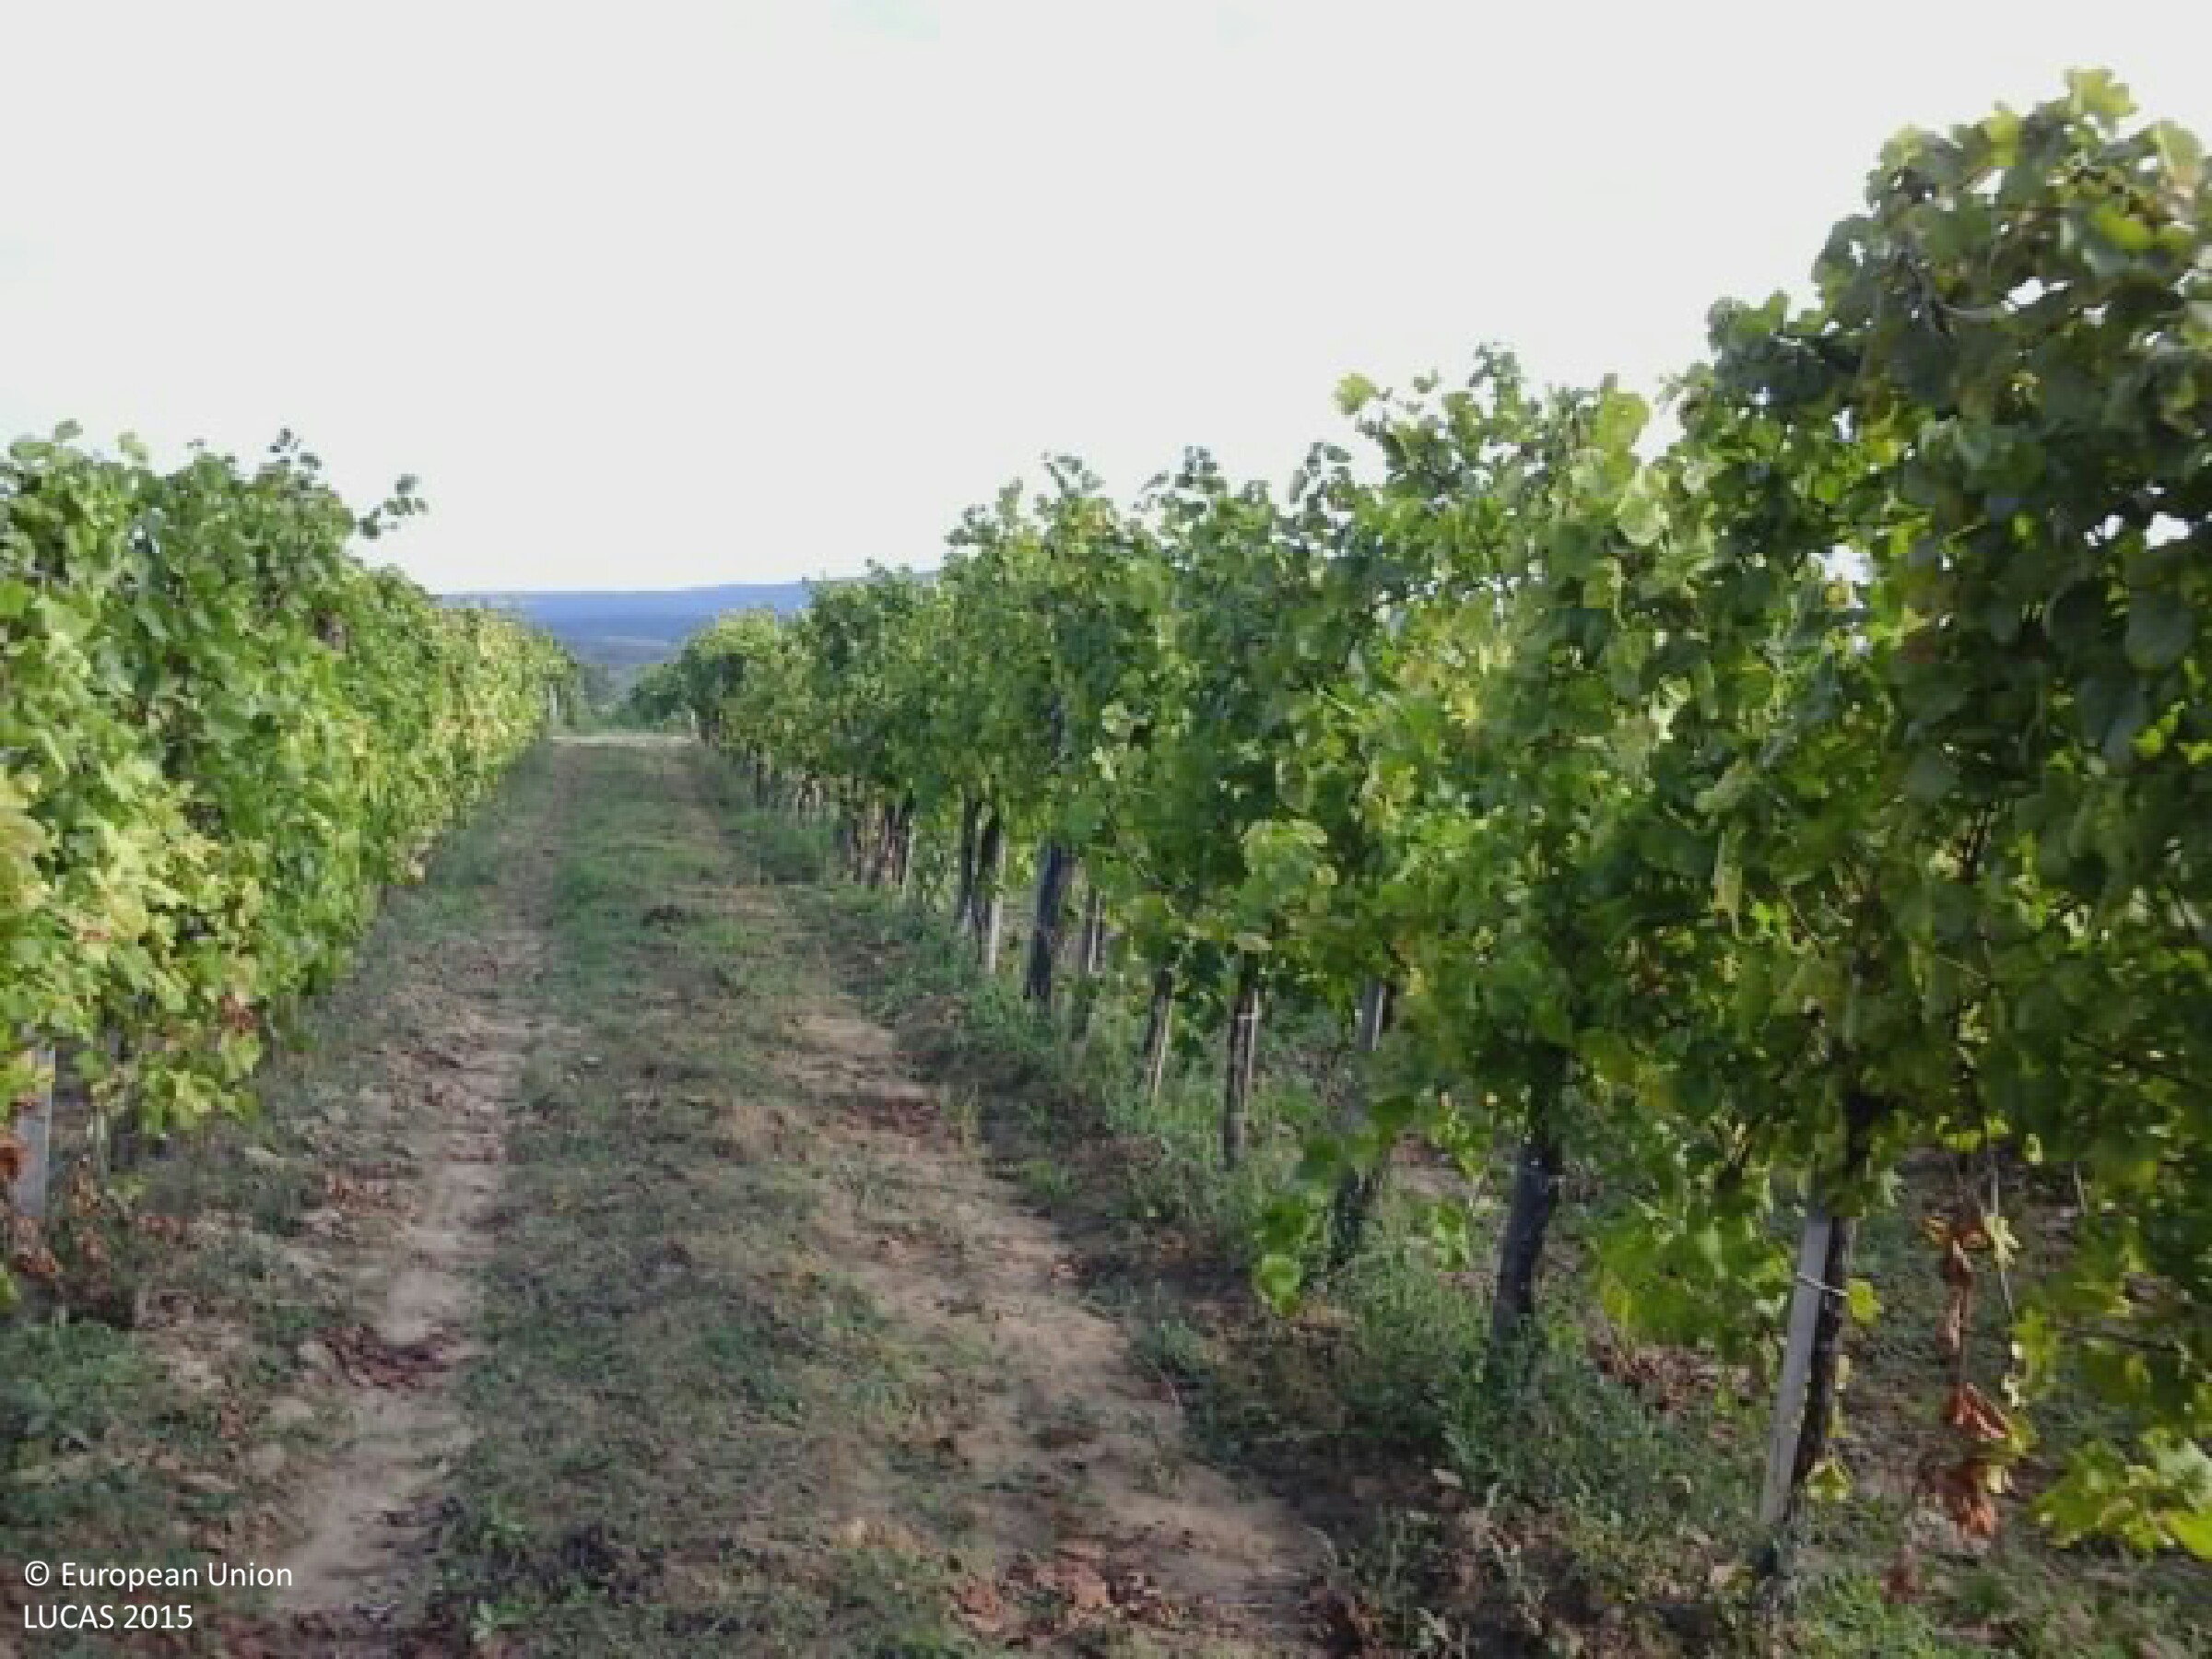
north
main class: Cropland
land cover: Vineyards
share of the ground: > 75 %
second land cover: Other bare soil
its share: > 75 %
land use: Agriculture (excluding fallow land and kitchen gardens)
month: September
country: HU
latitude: 47.7861
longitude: 19.9978
